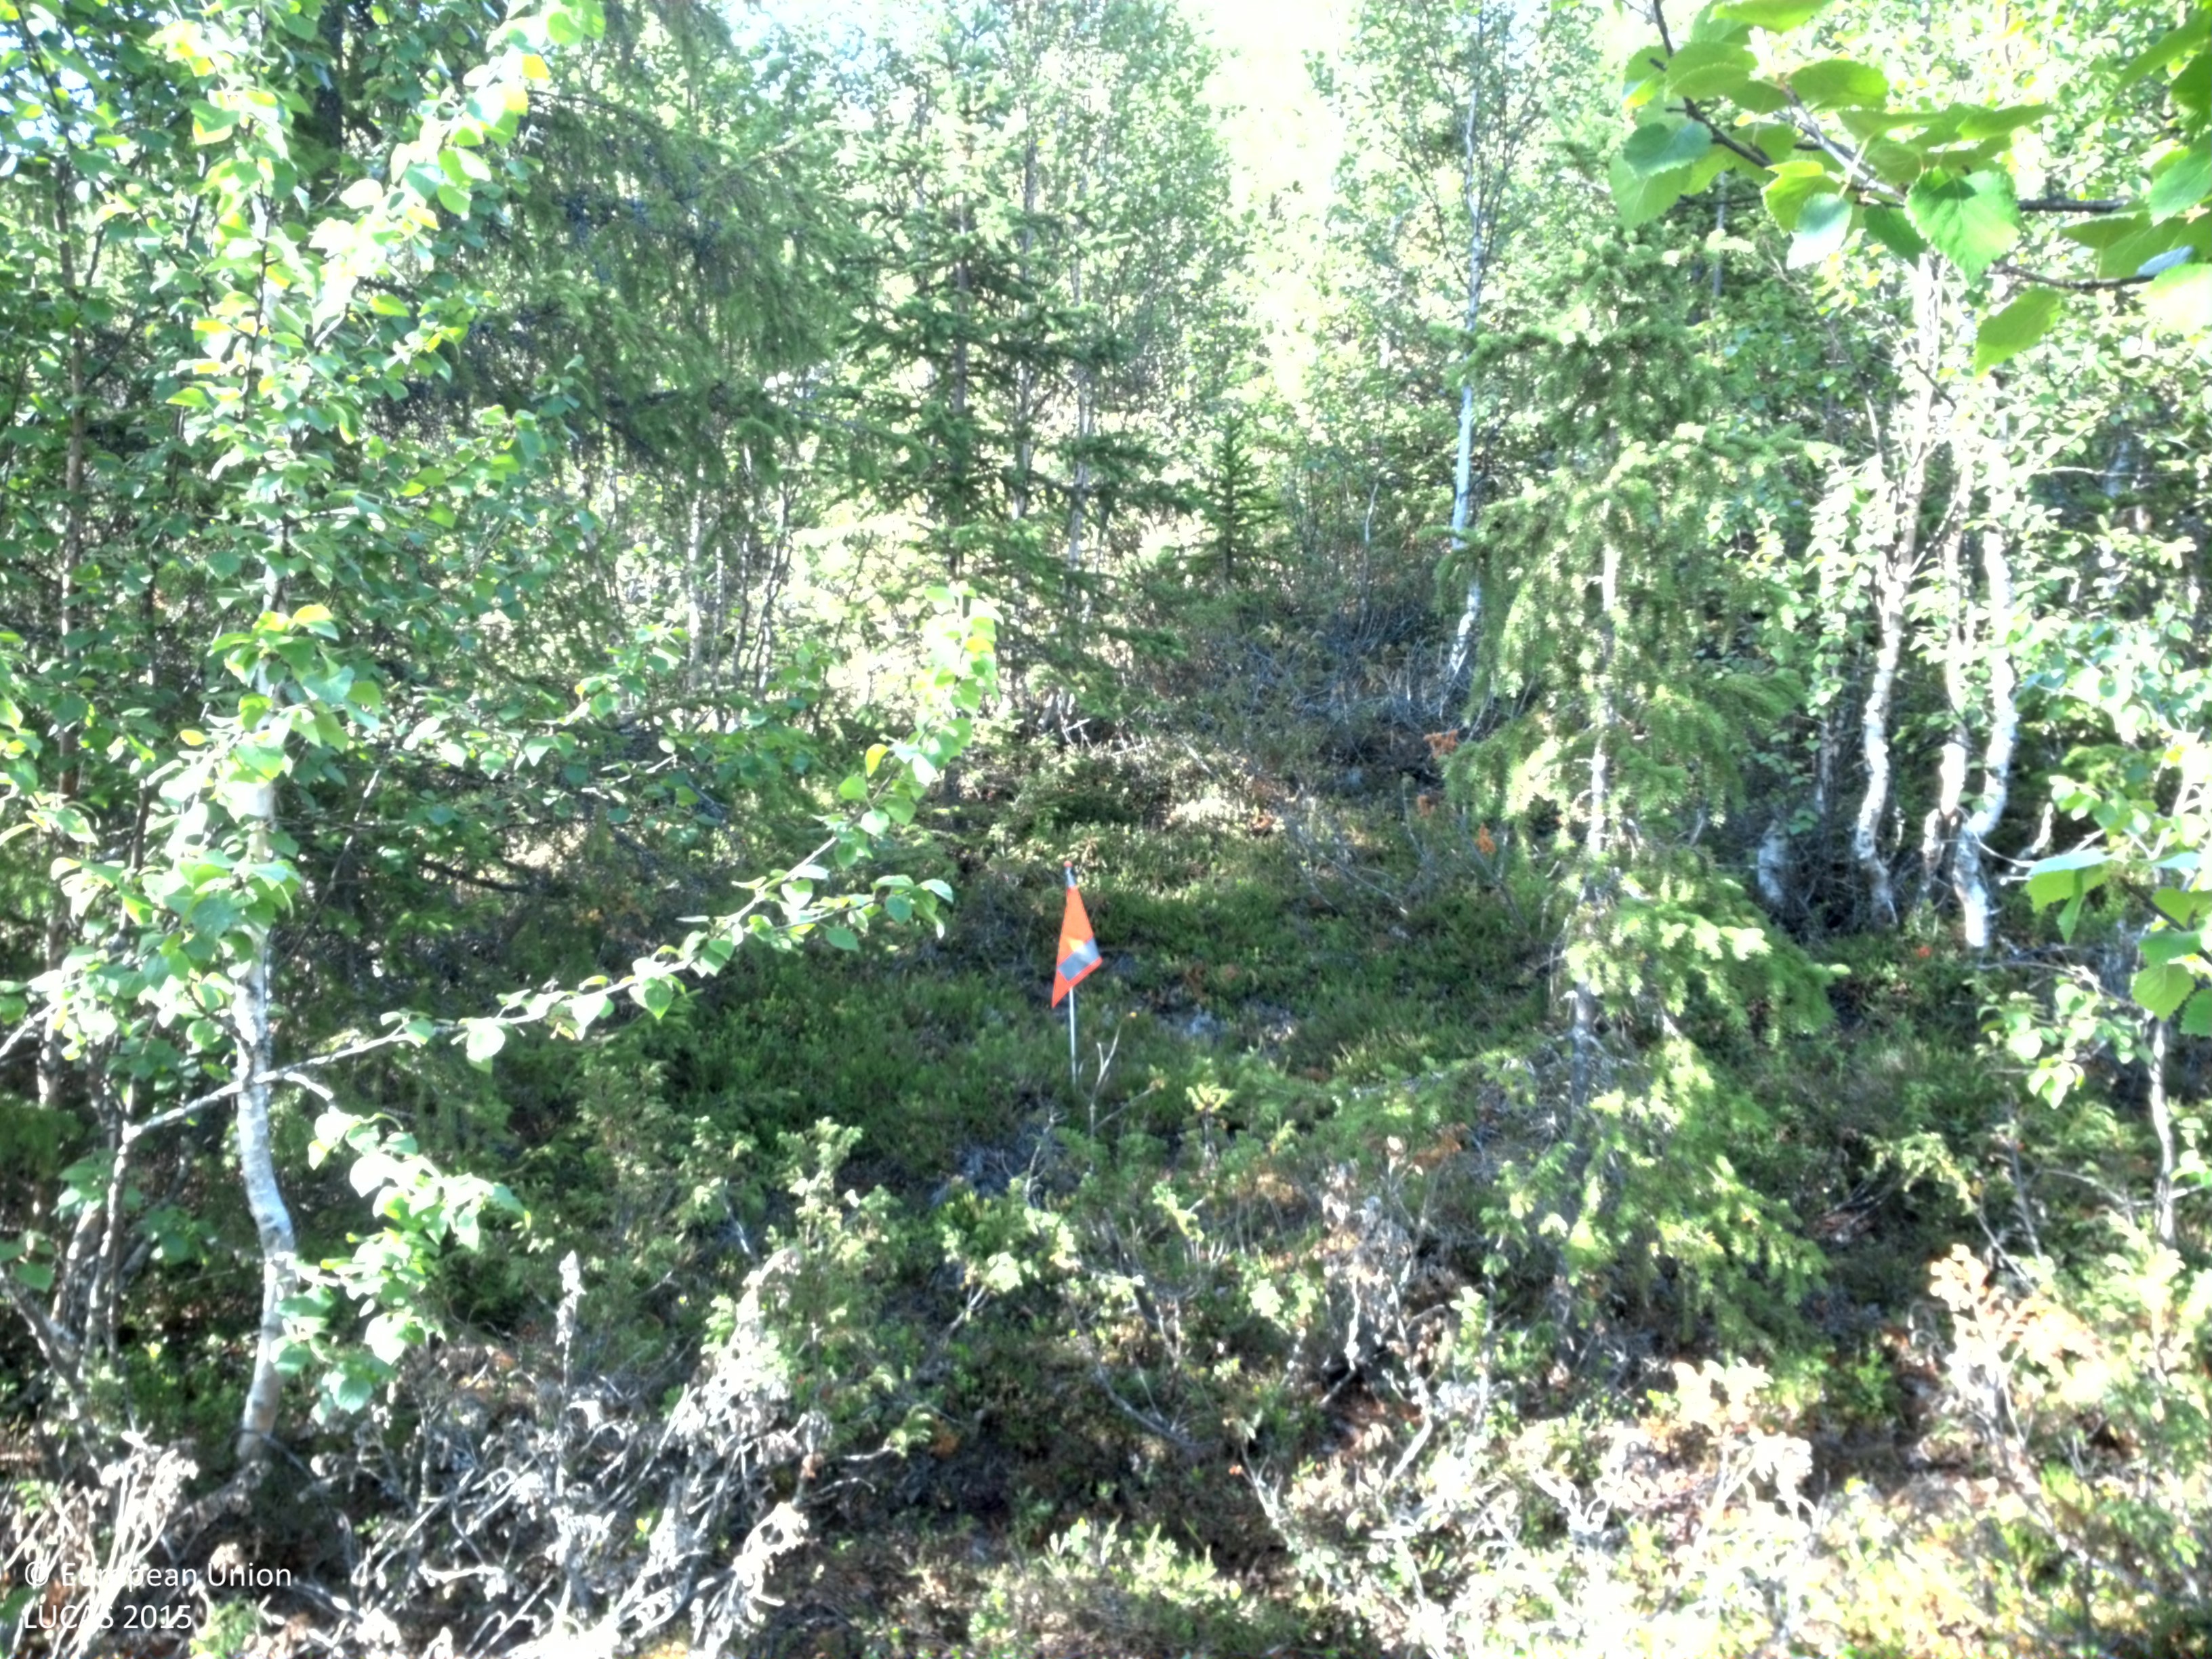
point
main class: Woodland
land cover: Spruce dominated mixed woodland
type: boreal forest
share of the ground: 25 - 50 %
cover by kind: shrubs 50 %, broadleaved forest trees 30 %, coniferous forest trees 10 %, lichens and mosses 10 %
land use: Forestry
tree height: > 5 m
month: August
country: SE
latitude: 65.0926
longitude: 16.1999
